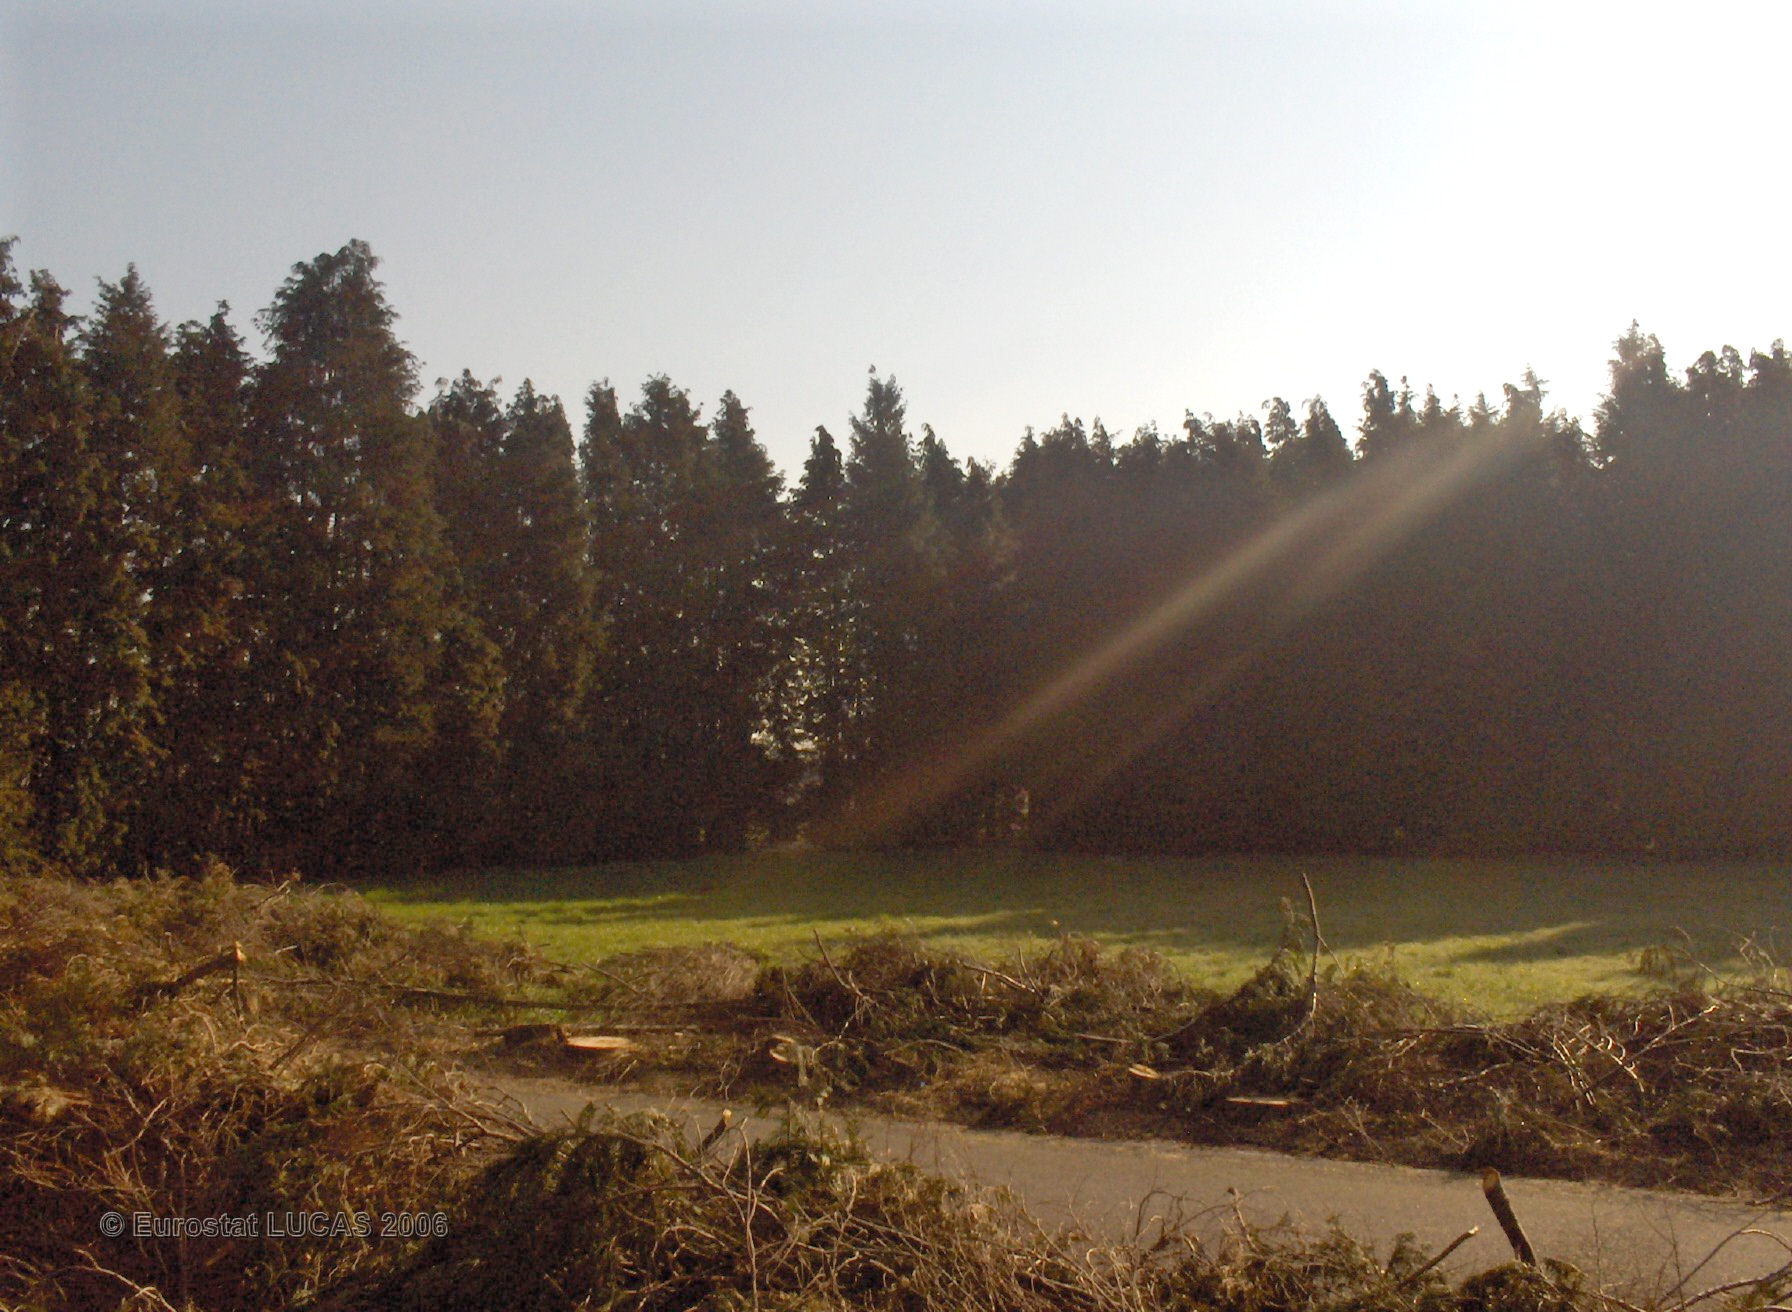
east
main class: Grassland
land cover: Grassland without tree/shrub cover
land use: Community services
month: April
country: BE
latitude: 50.4861
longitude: 4.5415
